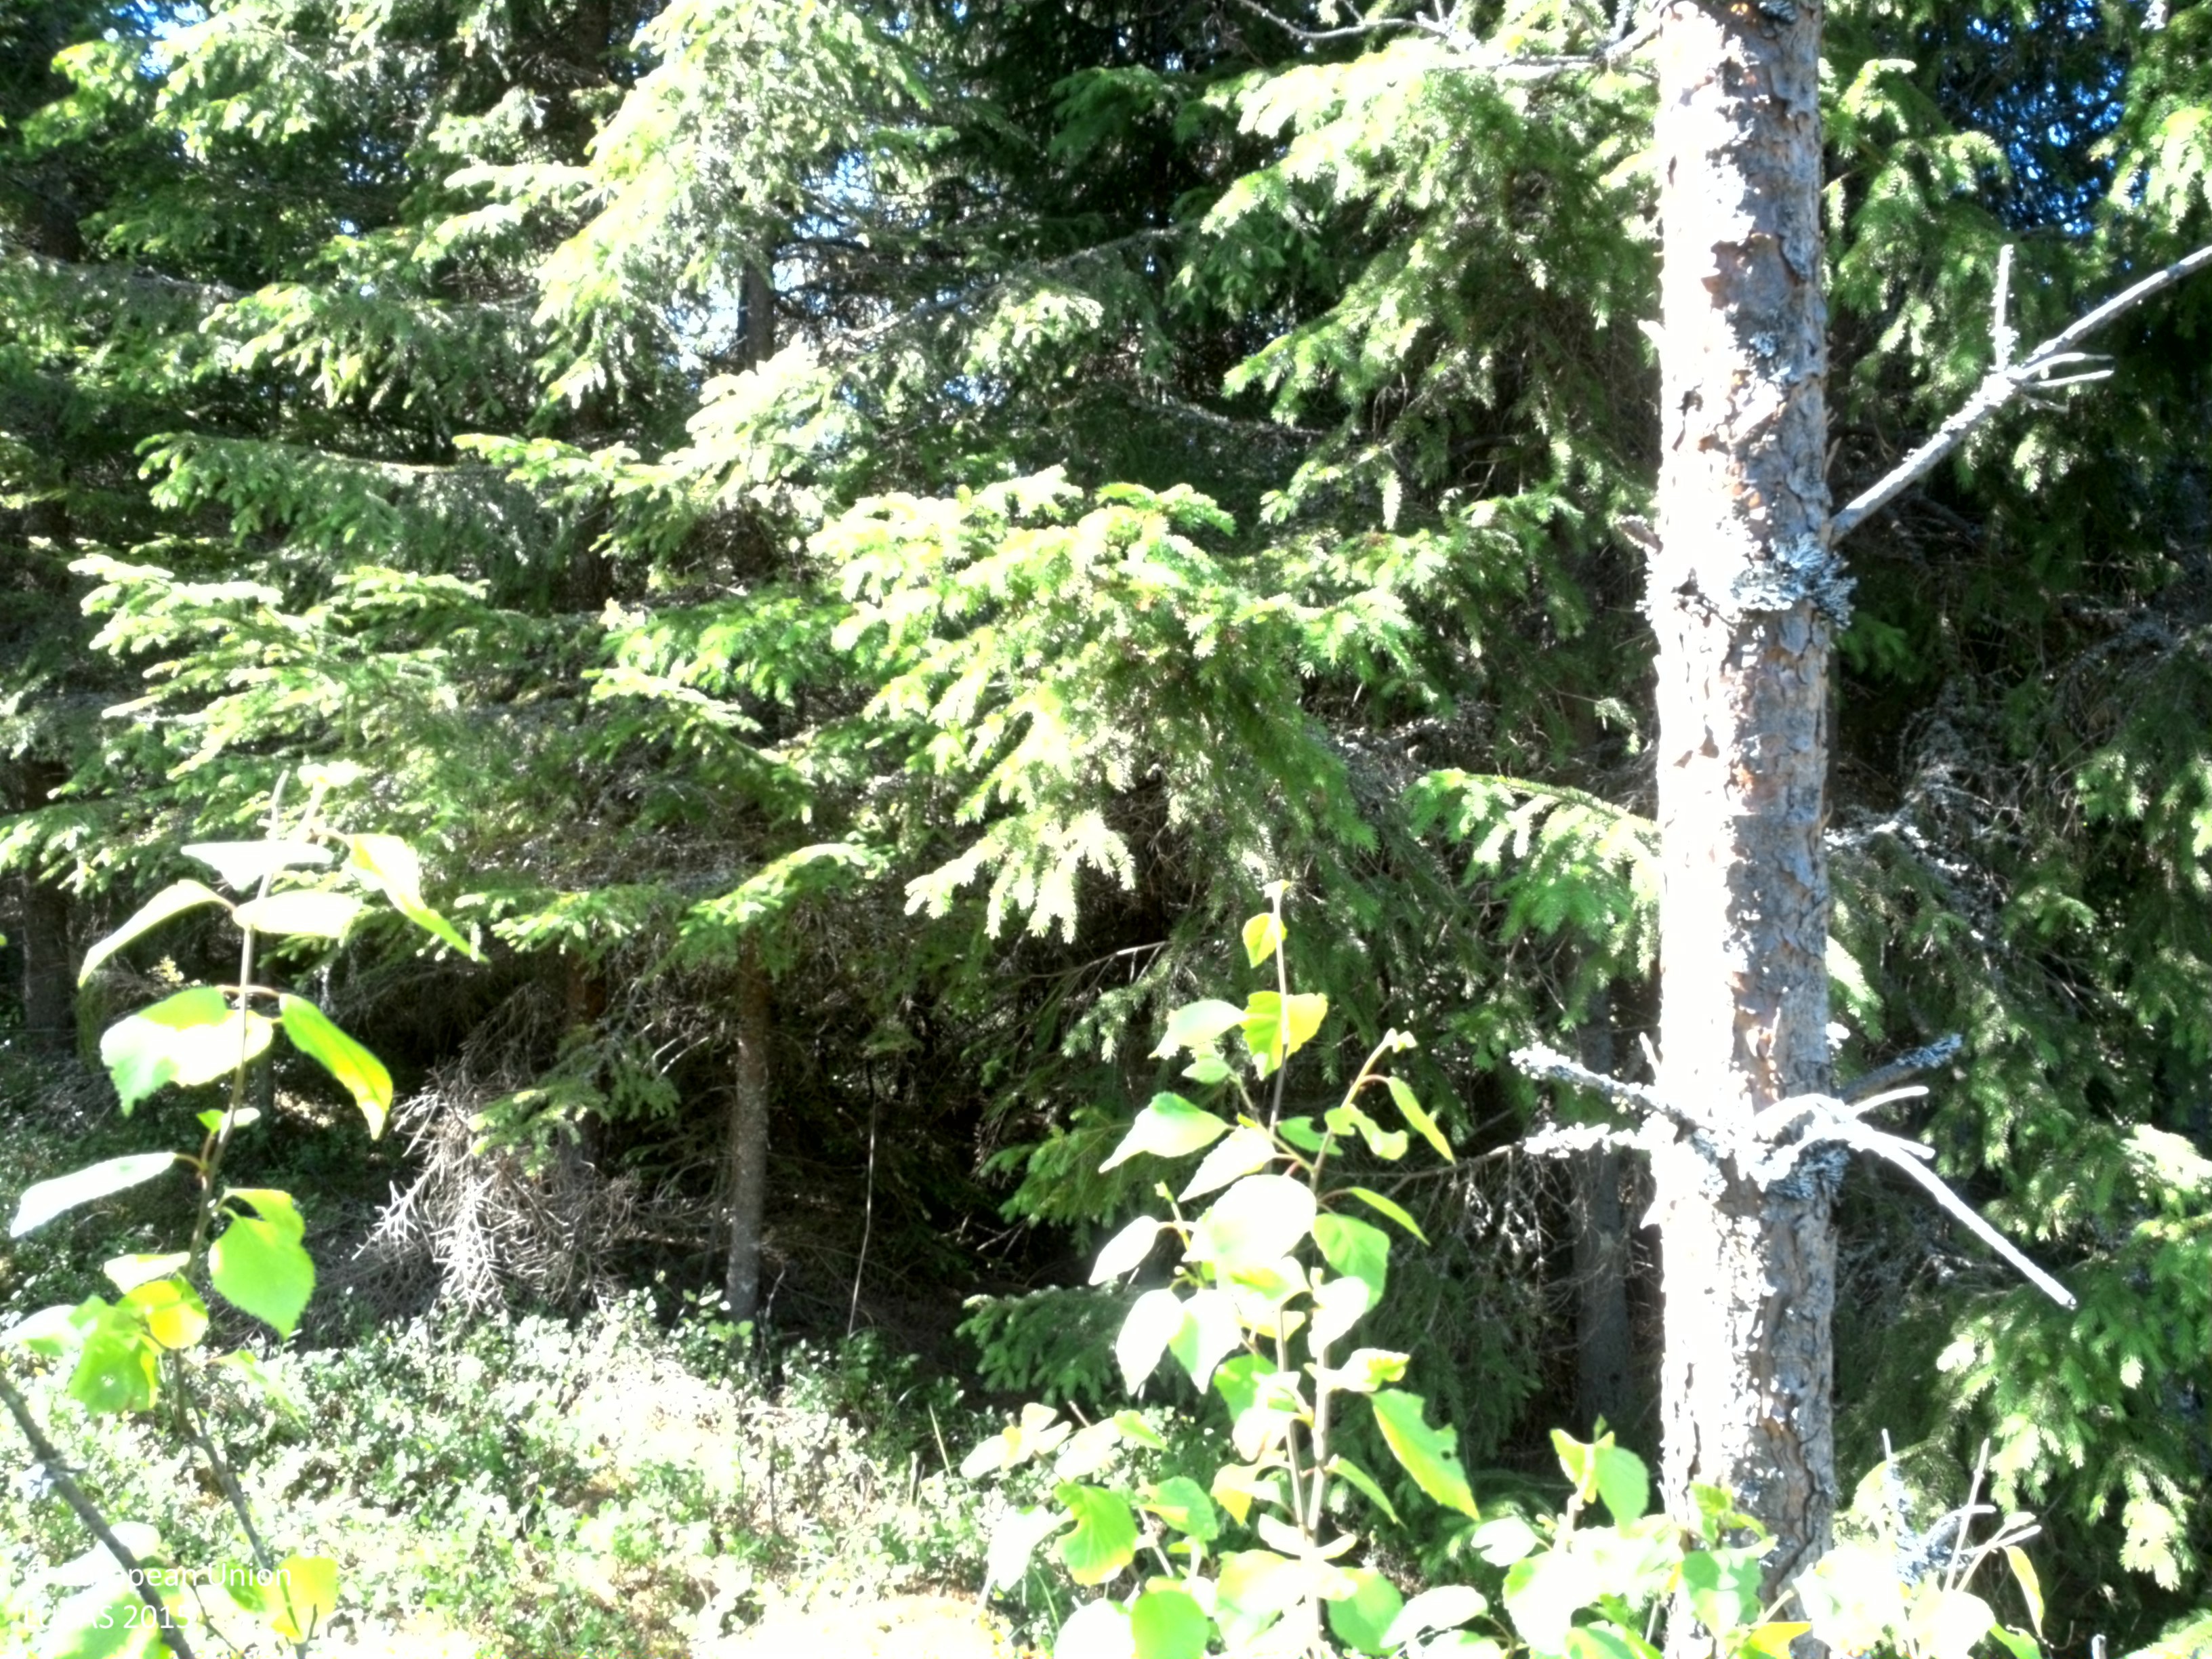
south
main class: Woodland
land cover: Other coniferous woodland
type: boreal forest
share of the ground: 50 - 75 %
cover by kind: coniferous forest trees 40 %, herbaceous plants 25 %, lichens and mosses 25 %, broadleaved forest trees 10 %
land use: Forestry
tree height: > 5 m
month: June
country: SE
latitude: 60.2142
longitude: 17.1920
